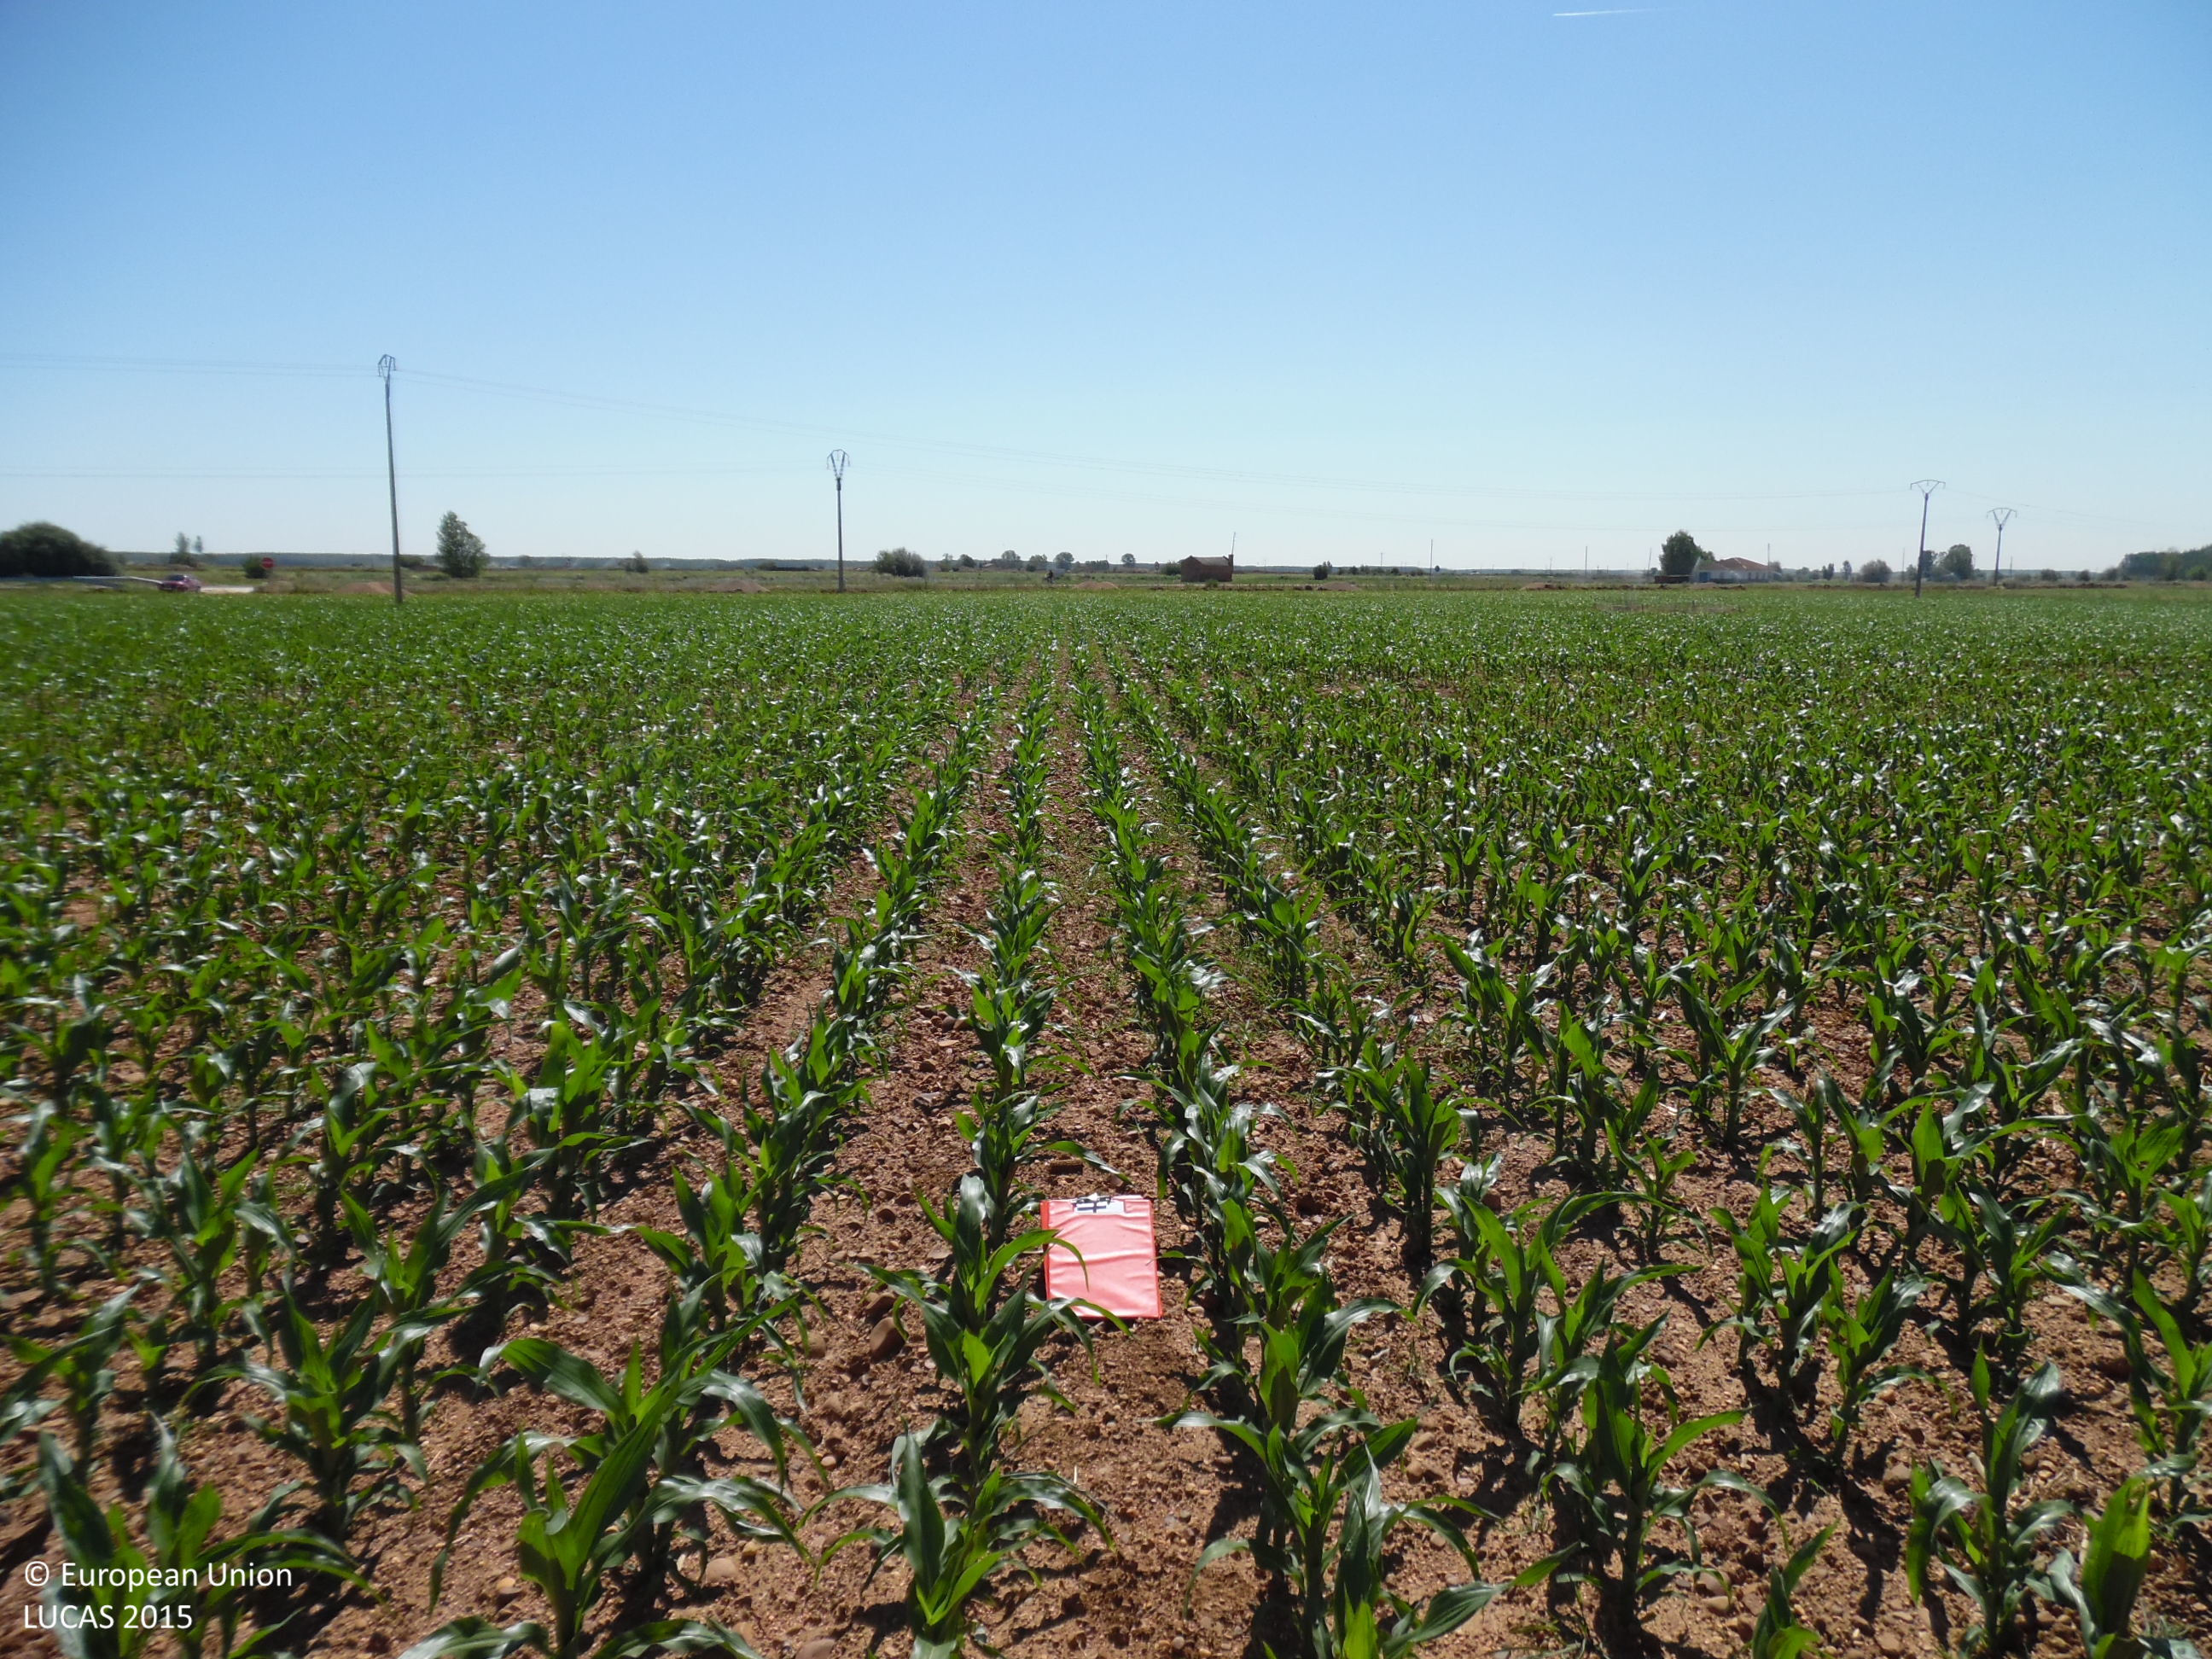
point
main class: Cropland
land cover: Maize
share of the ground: 50 - 75 %
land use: Agriculture (excluding fallow land and kitchen gardens)
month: June
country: ES
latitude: 42.2694
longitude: -5.6746
